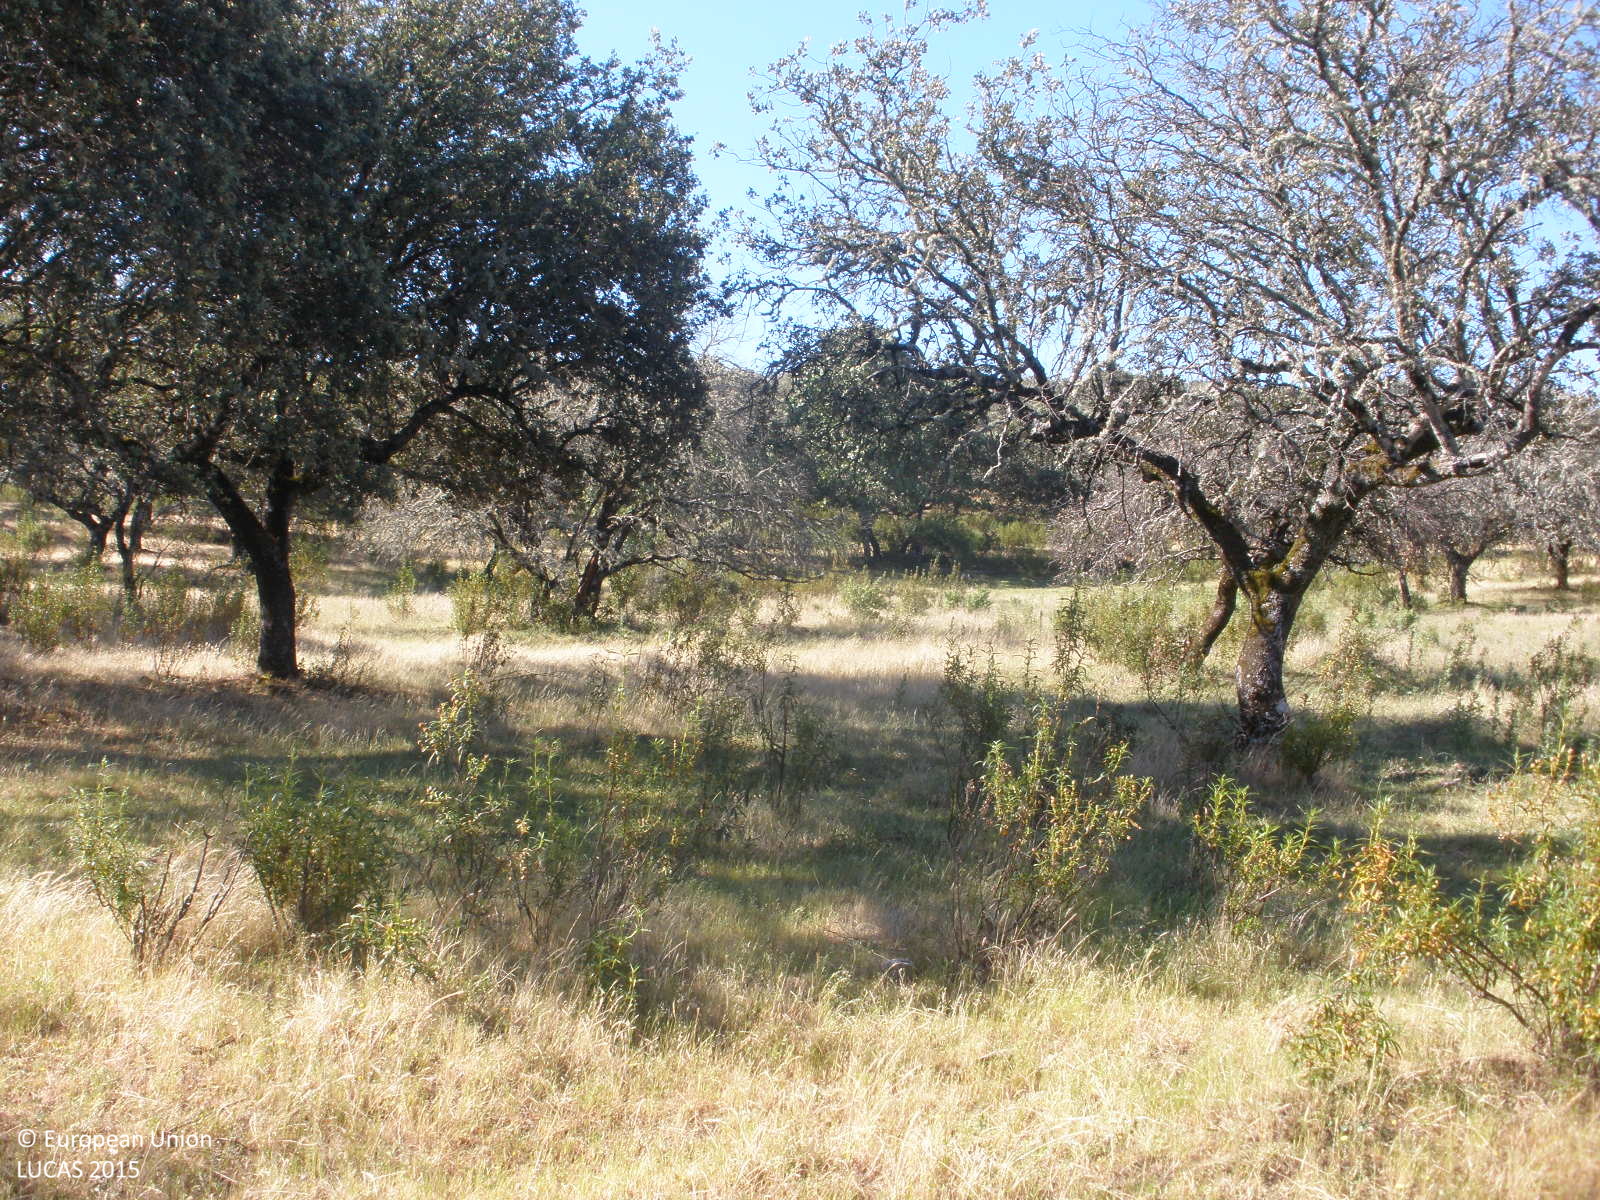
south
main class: Woodland
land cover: Broadleaved woodland
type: broadleaved evergreen forest
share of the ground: 50 - 75 %
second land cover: Grassland without tree/shrub cover
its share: > 75 %
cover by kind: herbaceous plants 60 %, broadleaved forest trees 35 %, shrubs 5 %
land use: Forestry
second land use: Agriculture (excluding fallow land and kitchen gardens)
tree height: < 5 m
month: May
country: ES
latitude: 40.2260
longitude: -6.2607
